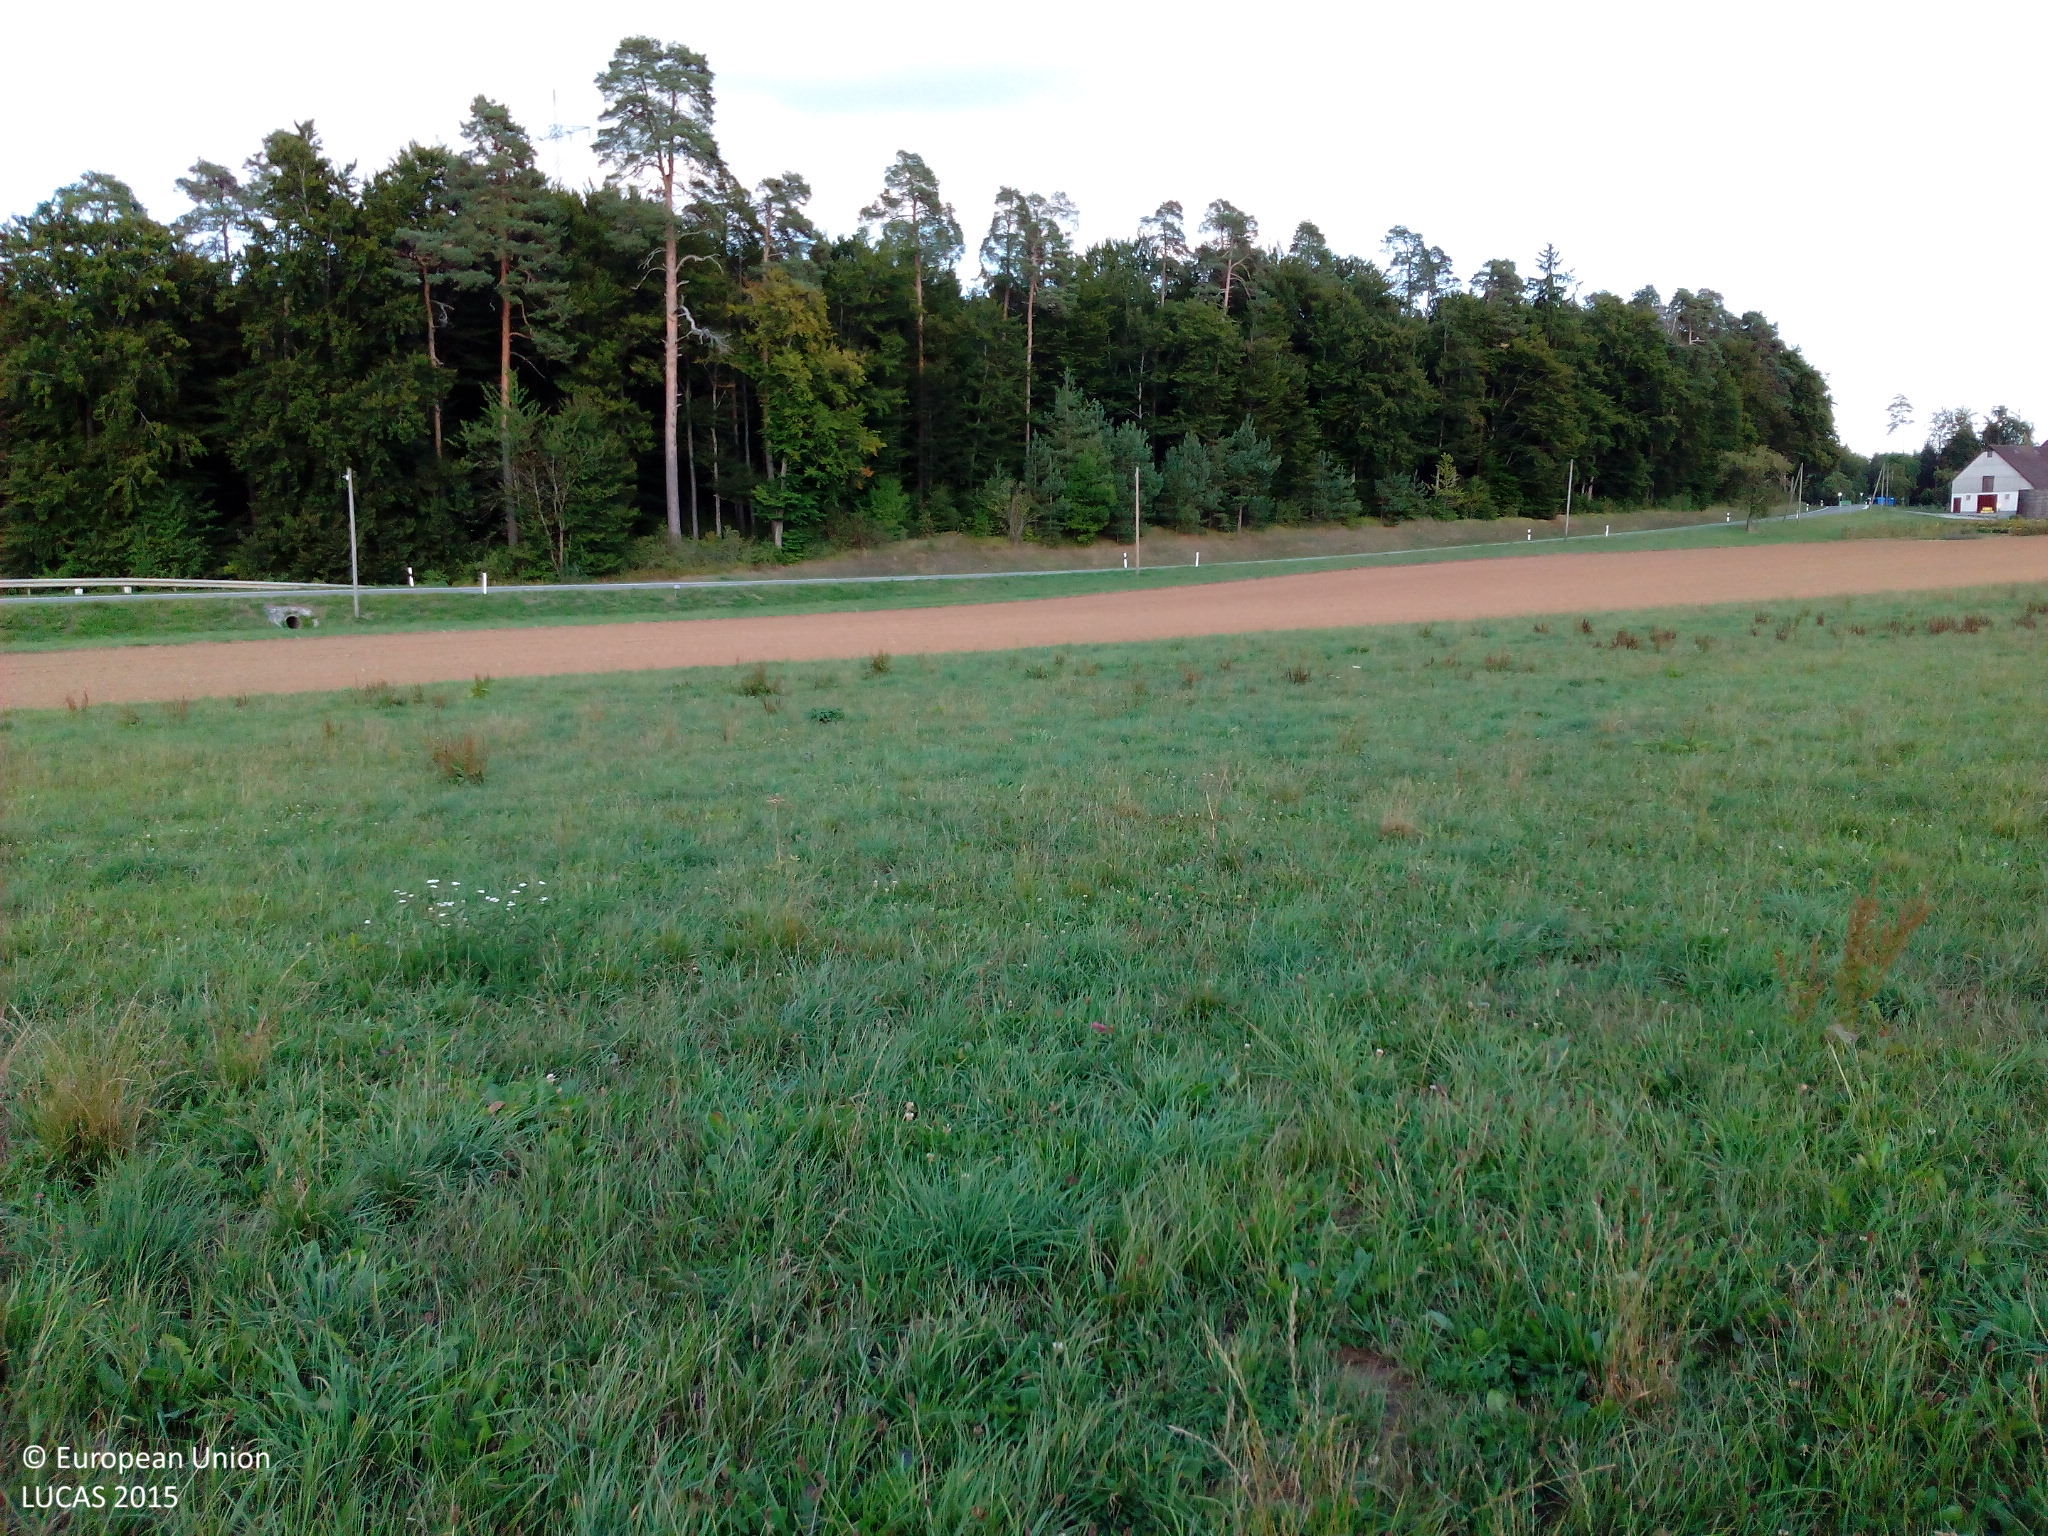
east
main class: Grassland
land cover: Grassland without tree/shrub cover
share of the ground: > 75 %
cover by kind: herbaceous plants 90 %, unconsolidated bare surface 10 %
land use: Agriculture (excluding fallow land and kitchen gardens)
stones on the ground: < 10 %
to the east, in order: Grassland without tree/shrub cover; Other bare soil; Grassland without tree/shrub cover; Electric lines; Grass margins; Paved roads, cycling and walking lanes; Grass margins; Ditches and canals; Grass margins; Pine dominated mixed woodland; Tracks; Spruce dominated coniferous woodland; Tracks; Spruce dominated coniferous woodland
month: September
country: DE
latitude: 48.1242
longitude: 8.5633
